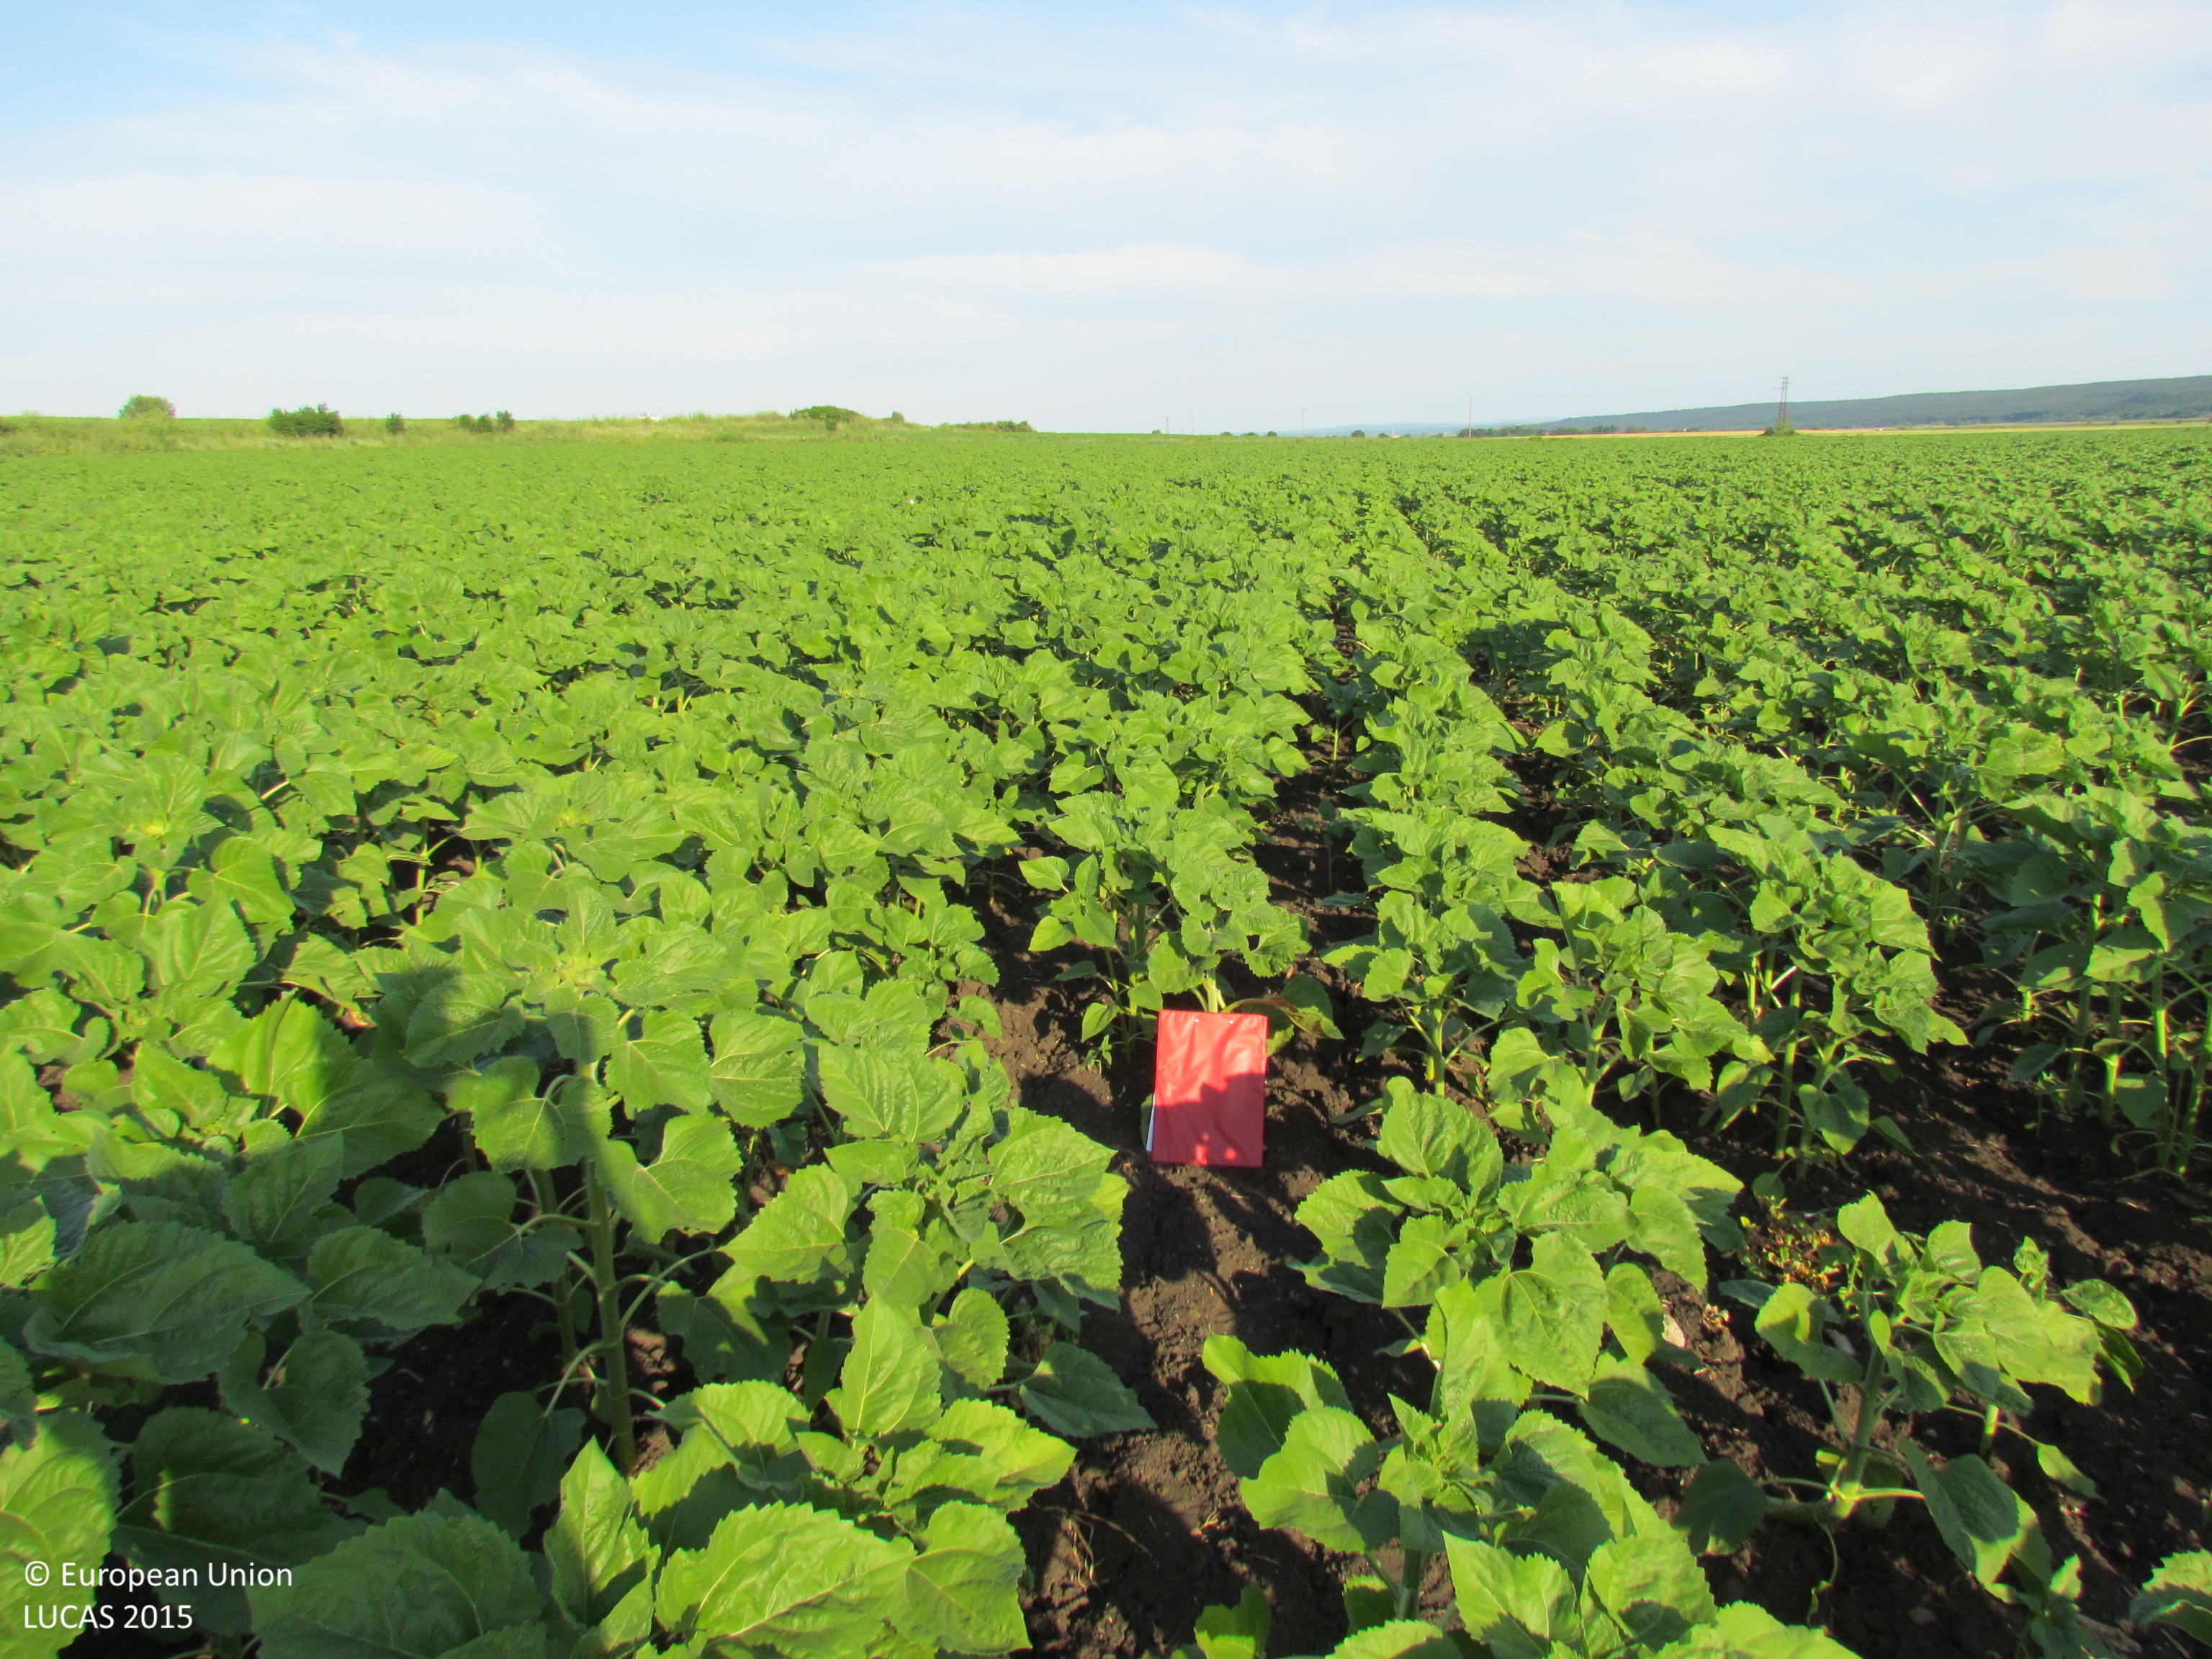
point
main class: Cropland
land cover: Sunflower
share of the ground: > 75 %
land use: Agriculture (excluding fallow land and kitchen gardens)
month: June
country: BG
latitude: 42.4600
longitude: 27.1950
